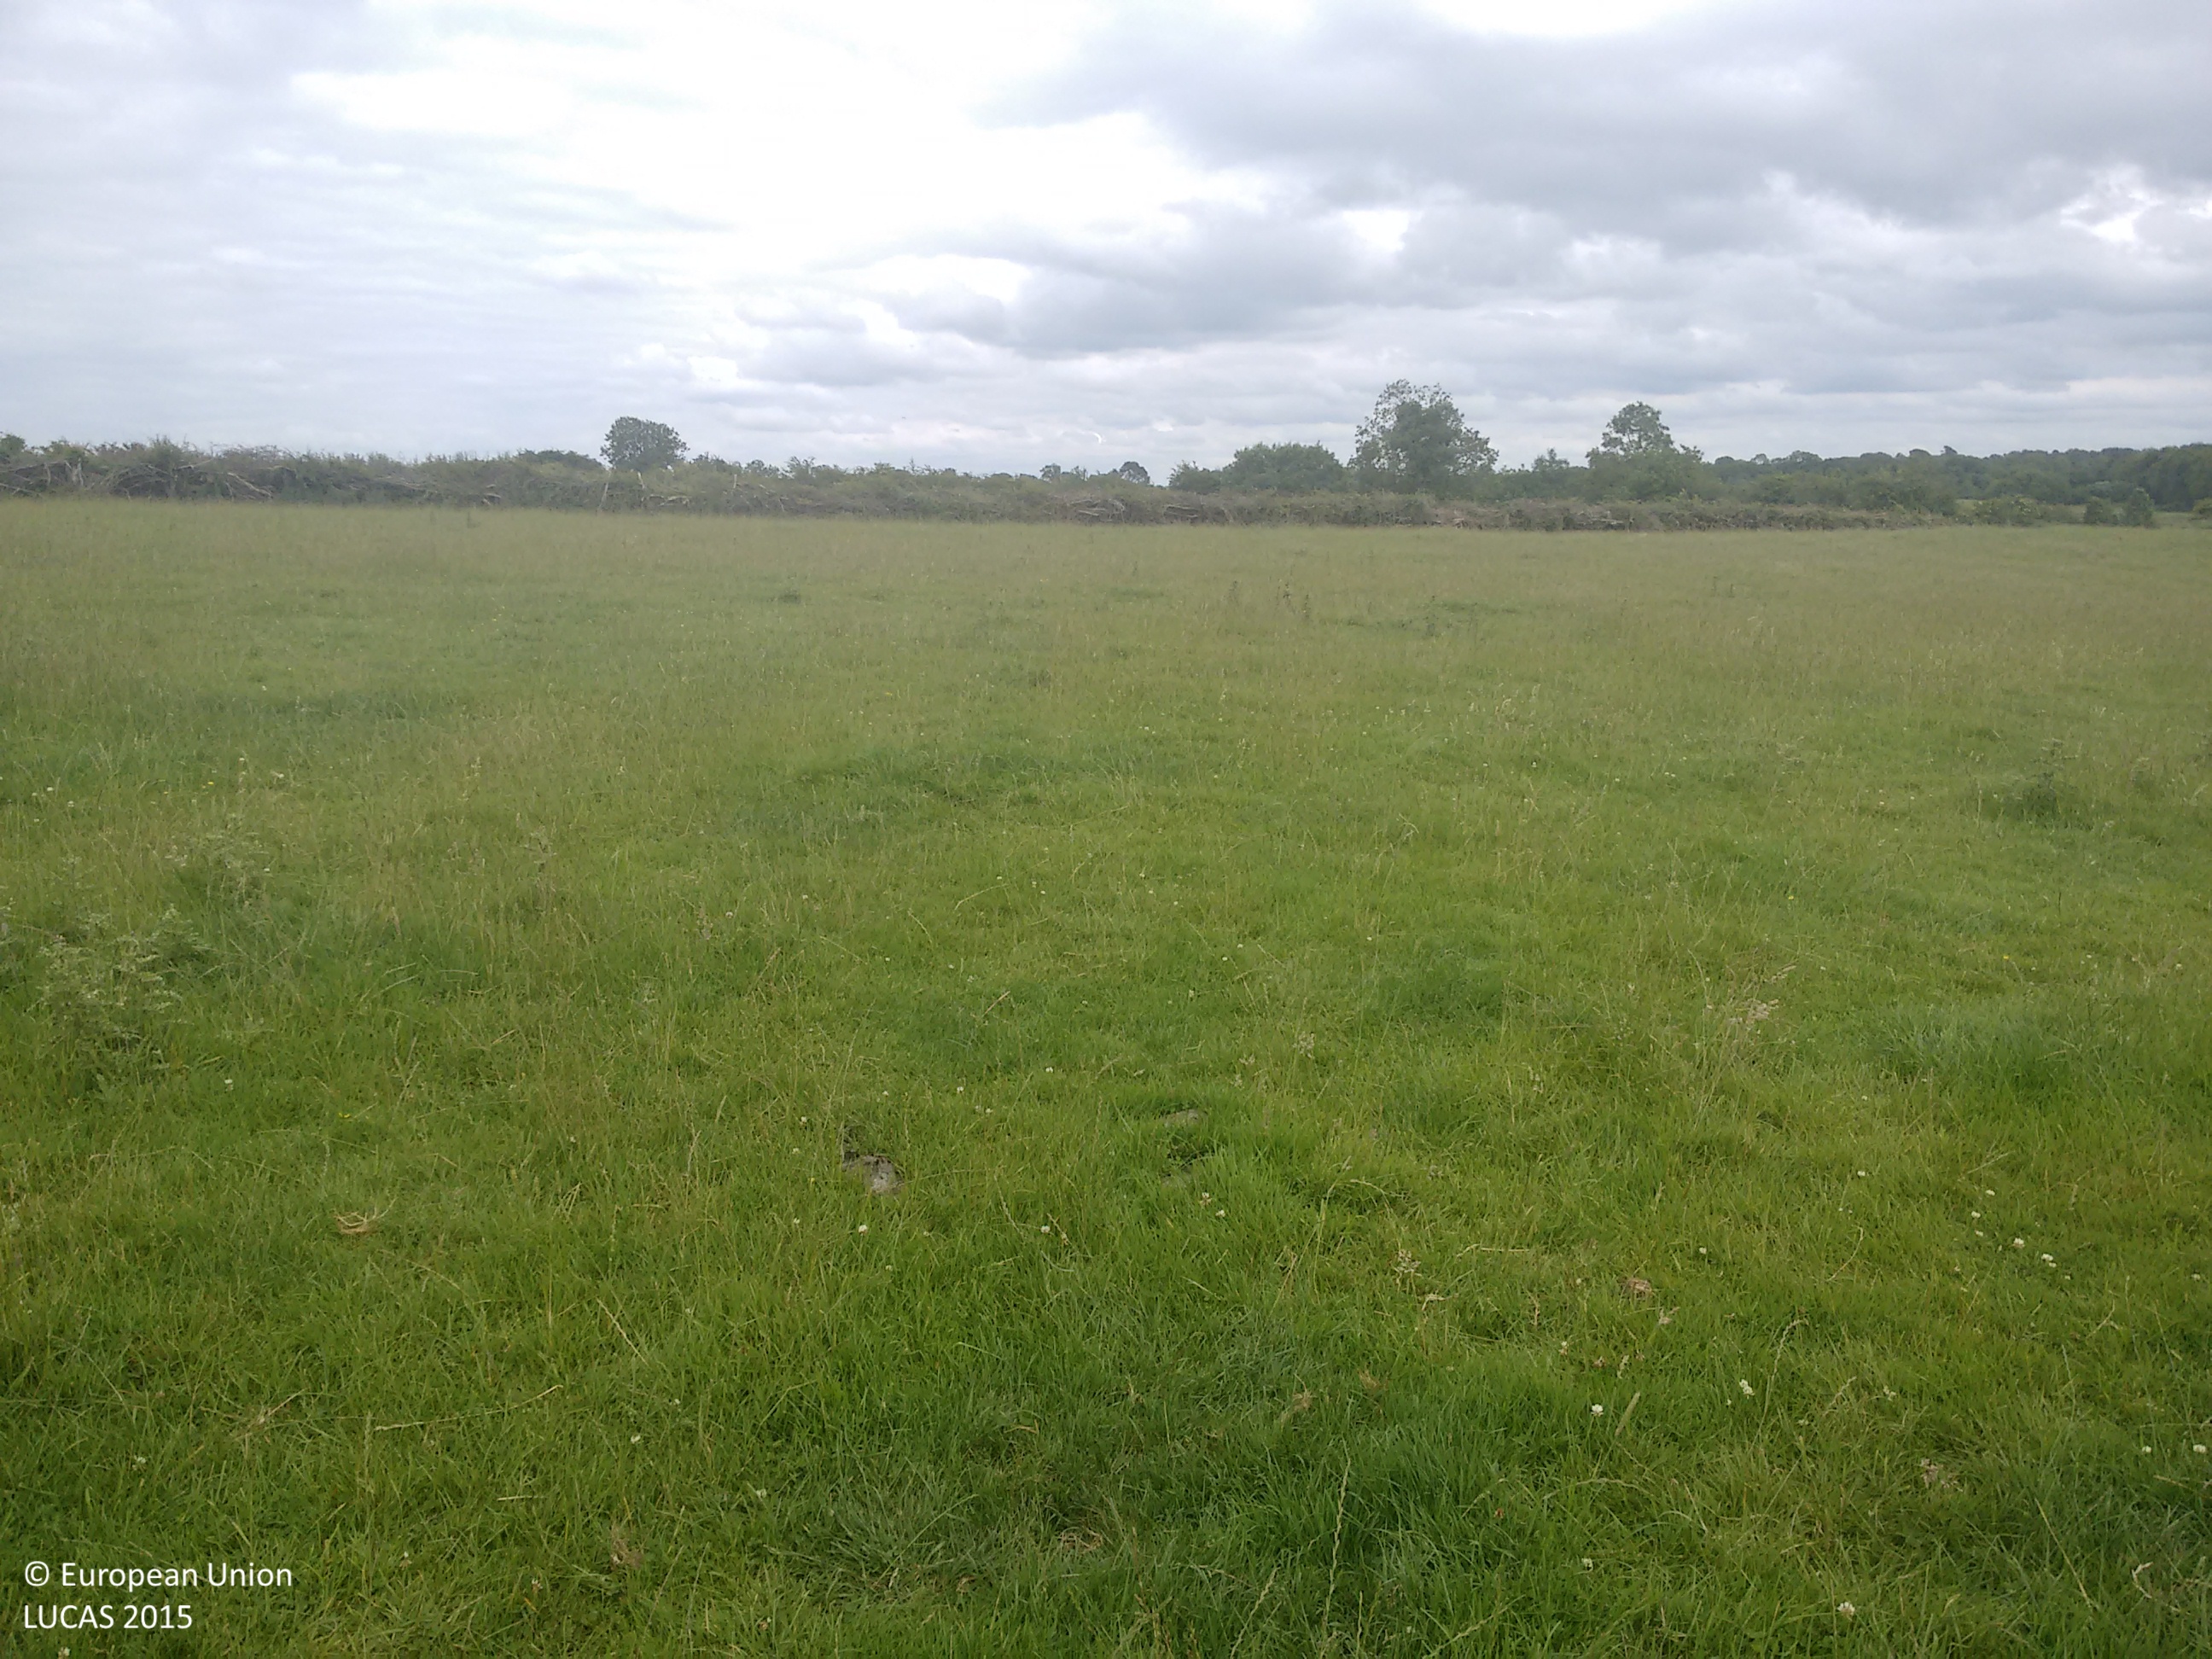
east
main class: Grassland
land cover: Grassland without tree/shrub cover
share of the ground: > 75 %
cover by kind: herbaceous plants 100 %
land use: Agriculture (excluding fallow land and kitchen gardens)
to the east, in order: Grassland without tree/shrub cover; Ditches and canals; Managed hedges; Grassland without tree/shrub cover; Managed hedges; Grassland without tree/shrub cover
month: July
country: IE
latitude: 53.5069
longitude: -7.6691
